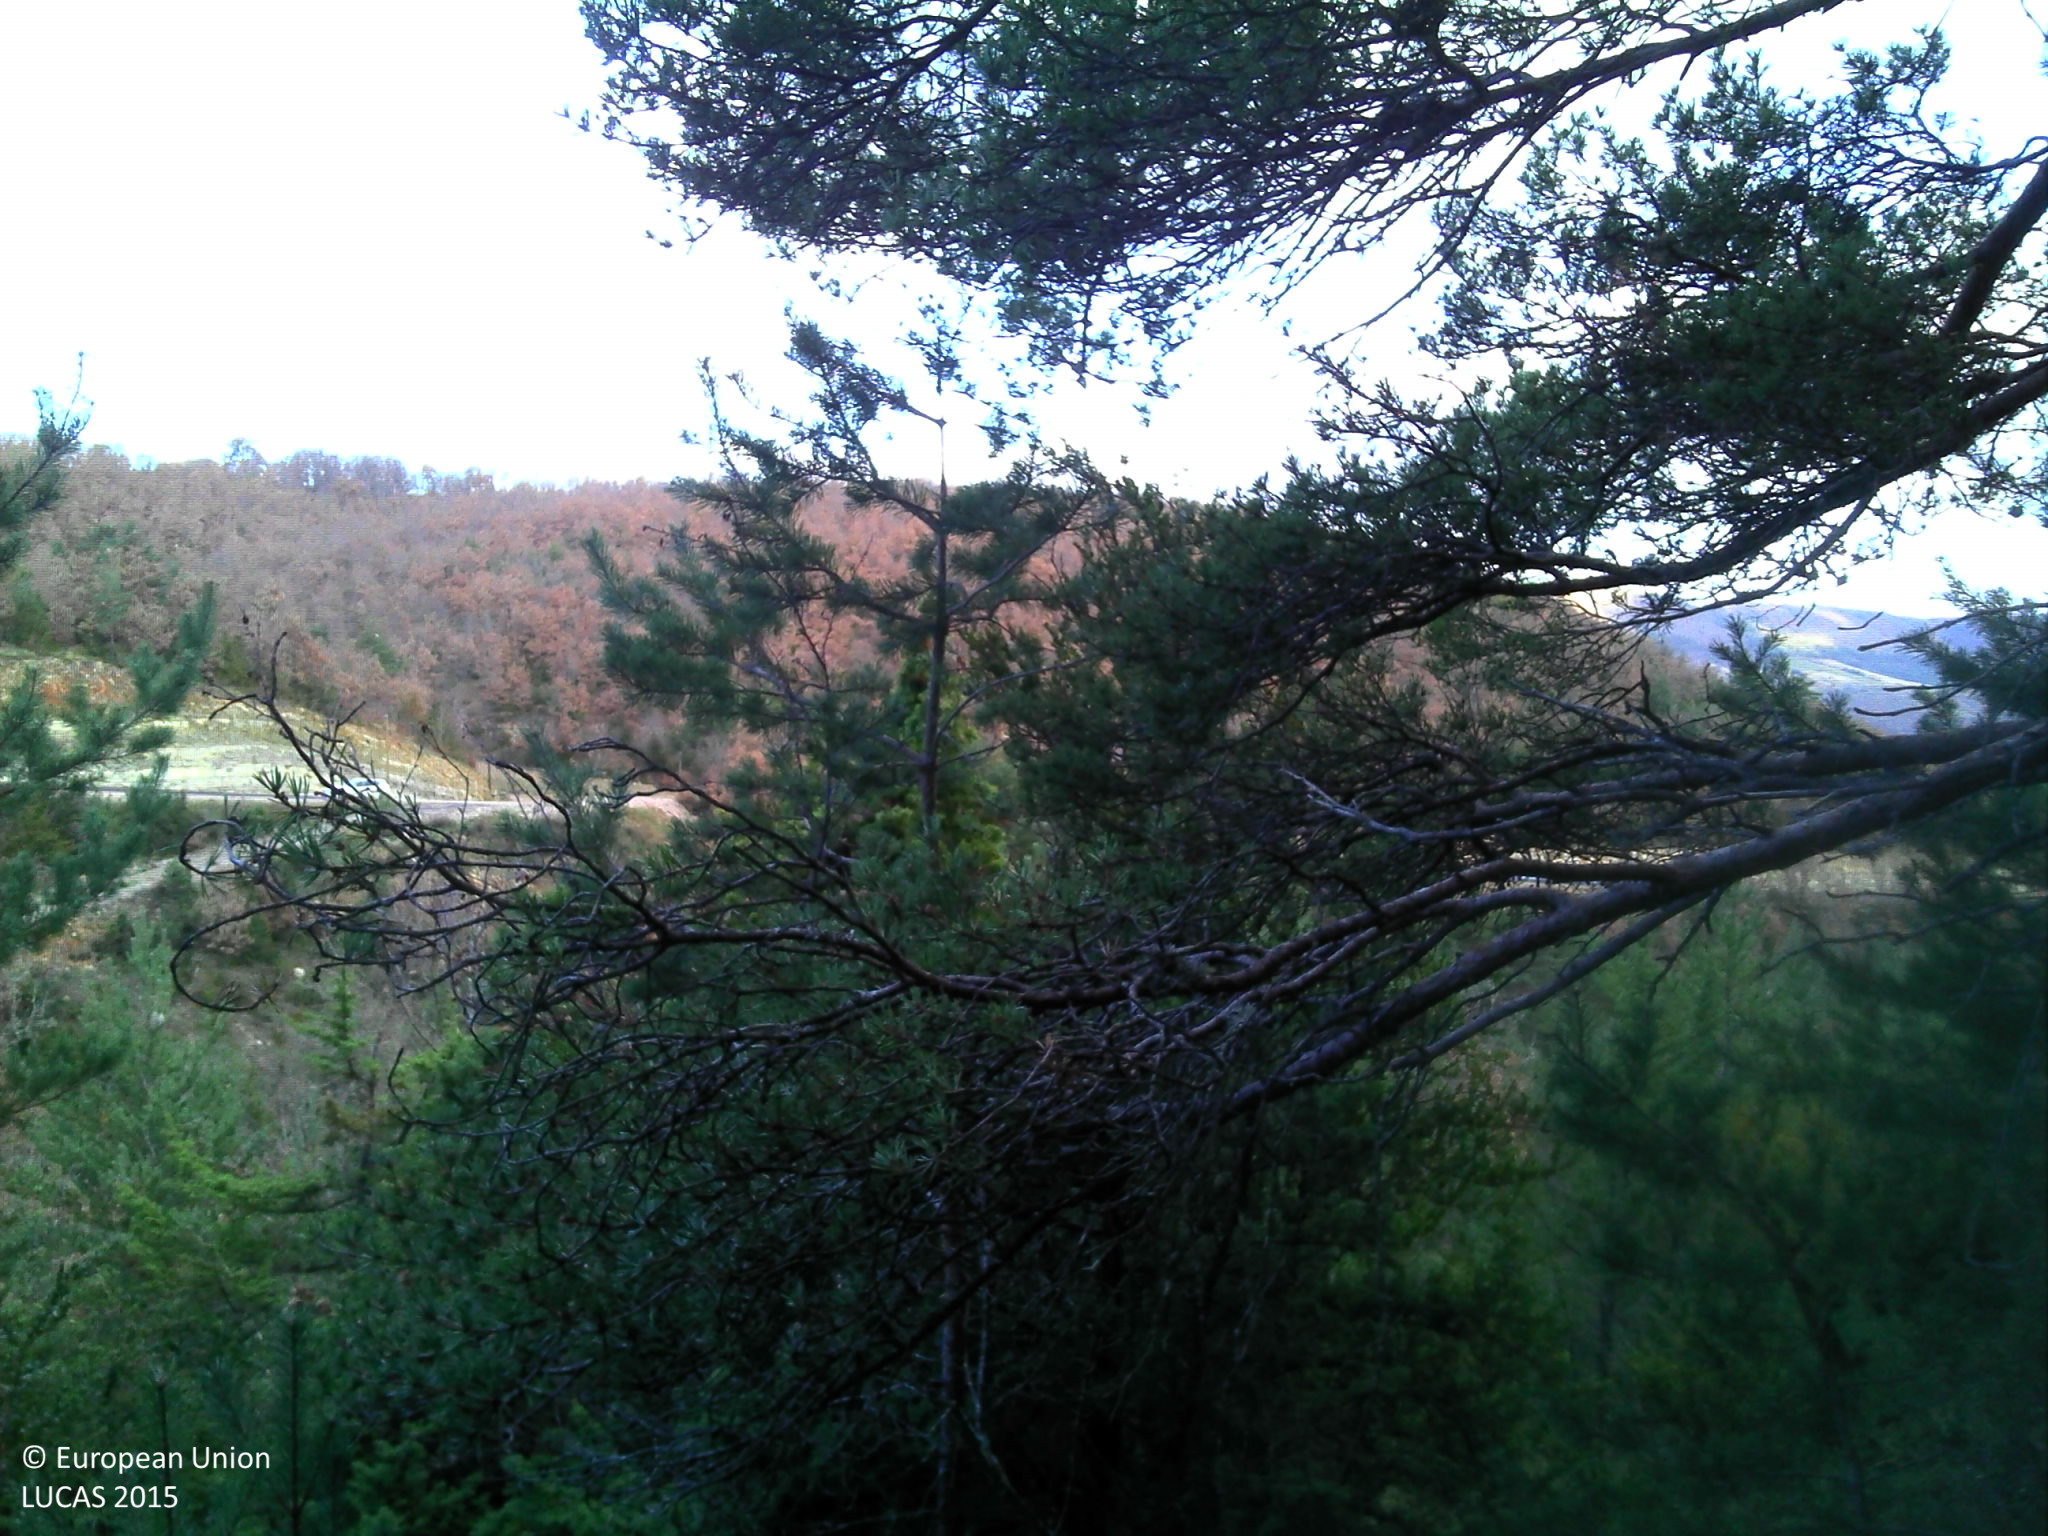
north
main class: Woodland
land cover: Pine dominated mixed woodland
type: thermophilous deciduous forest
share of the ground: > 75 %
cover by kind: coniferous forest trees 60 %, broadleaved forest trees 20 %, shrubs 10 %, herbaceous plants 10 %
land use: Forestry
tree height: > 5 m
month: November
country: FR
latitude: 43.9899
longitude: 3.3111
